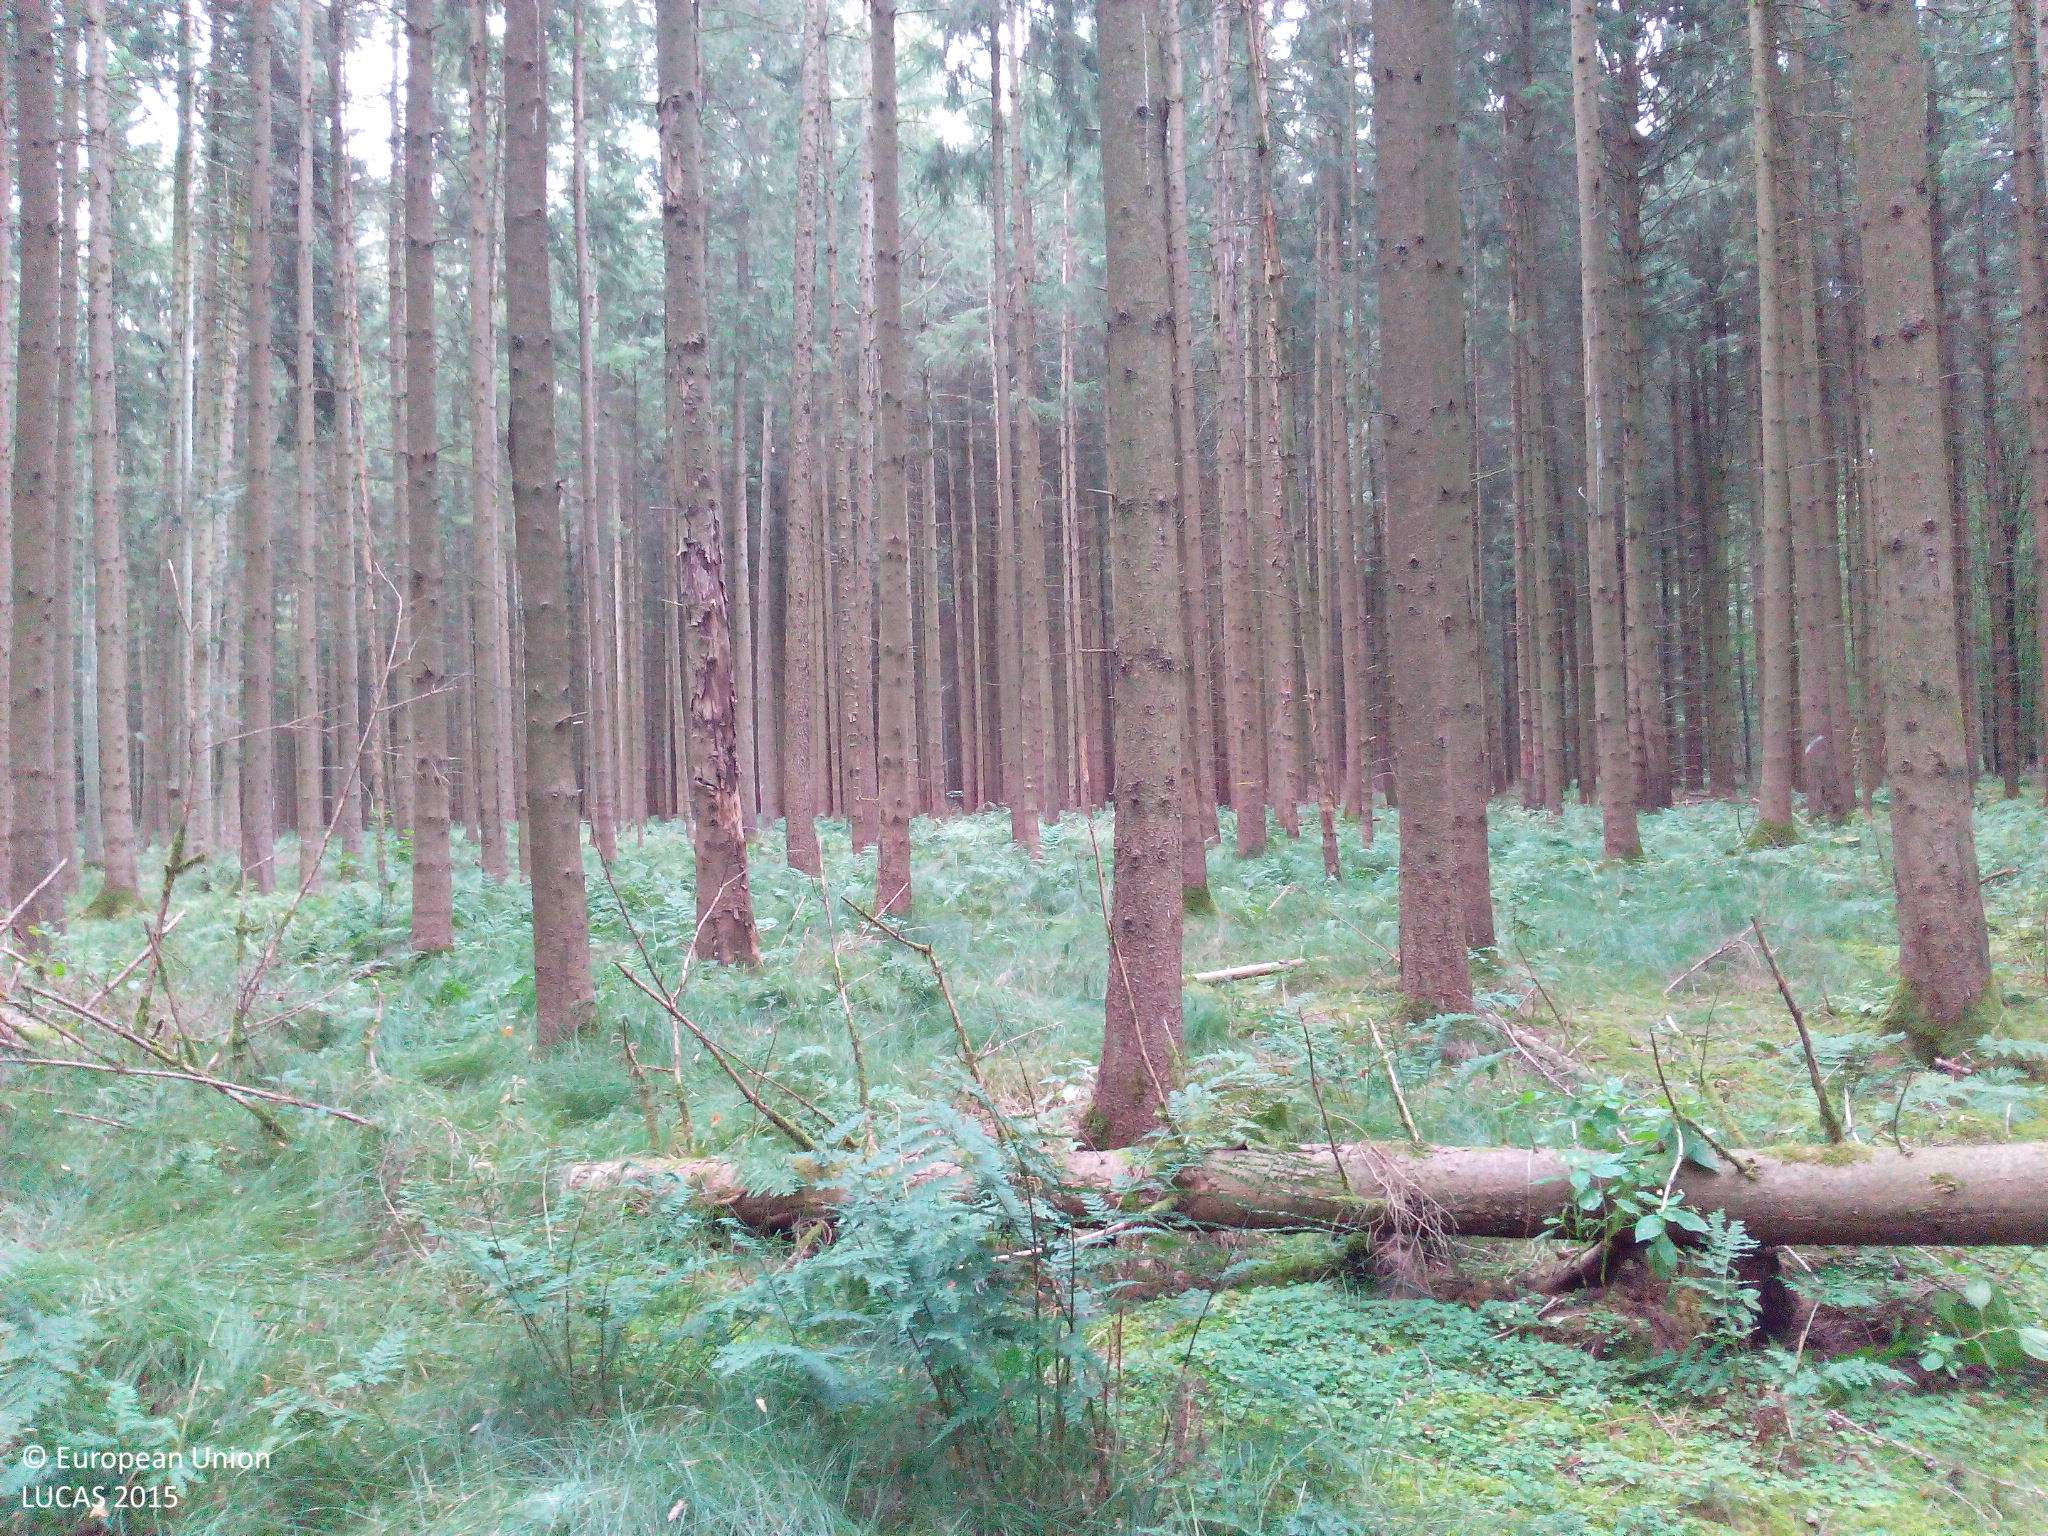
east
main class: Woodland
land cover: Spruce dominated coniferous woodland
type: hemiboreal forest and nemoral coniferous forest and mixed broadleaved-coniferous forest
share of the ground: > 75 %
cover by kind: coniferous forest trees 80 %, broadleaved forest trees 10 %, lichens and mosses 10 %
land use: Forestry
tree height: > 5 m
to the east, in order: Spruce dominated coniferous woodland; Tracks; Spruce dominated coniferous woodland; Tracks; Spruce dominated coniferous woodland; Tracks; Other mixed woodland
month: September
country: DE
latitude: 48.4742
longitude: 10.5273
